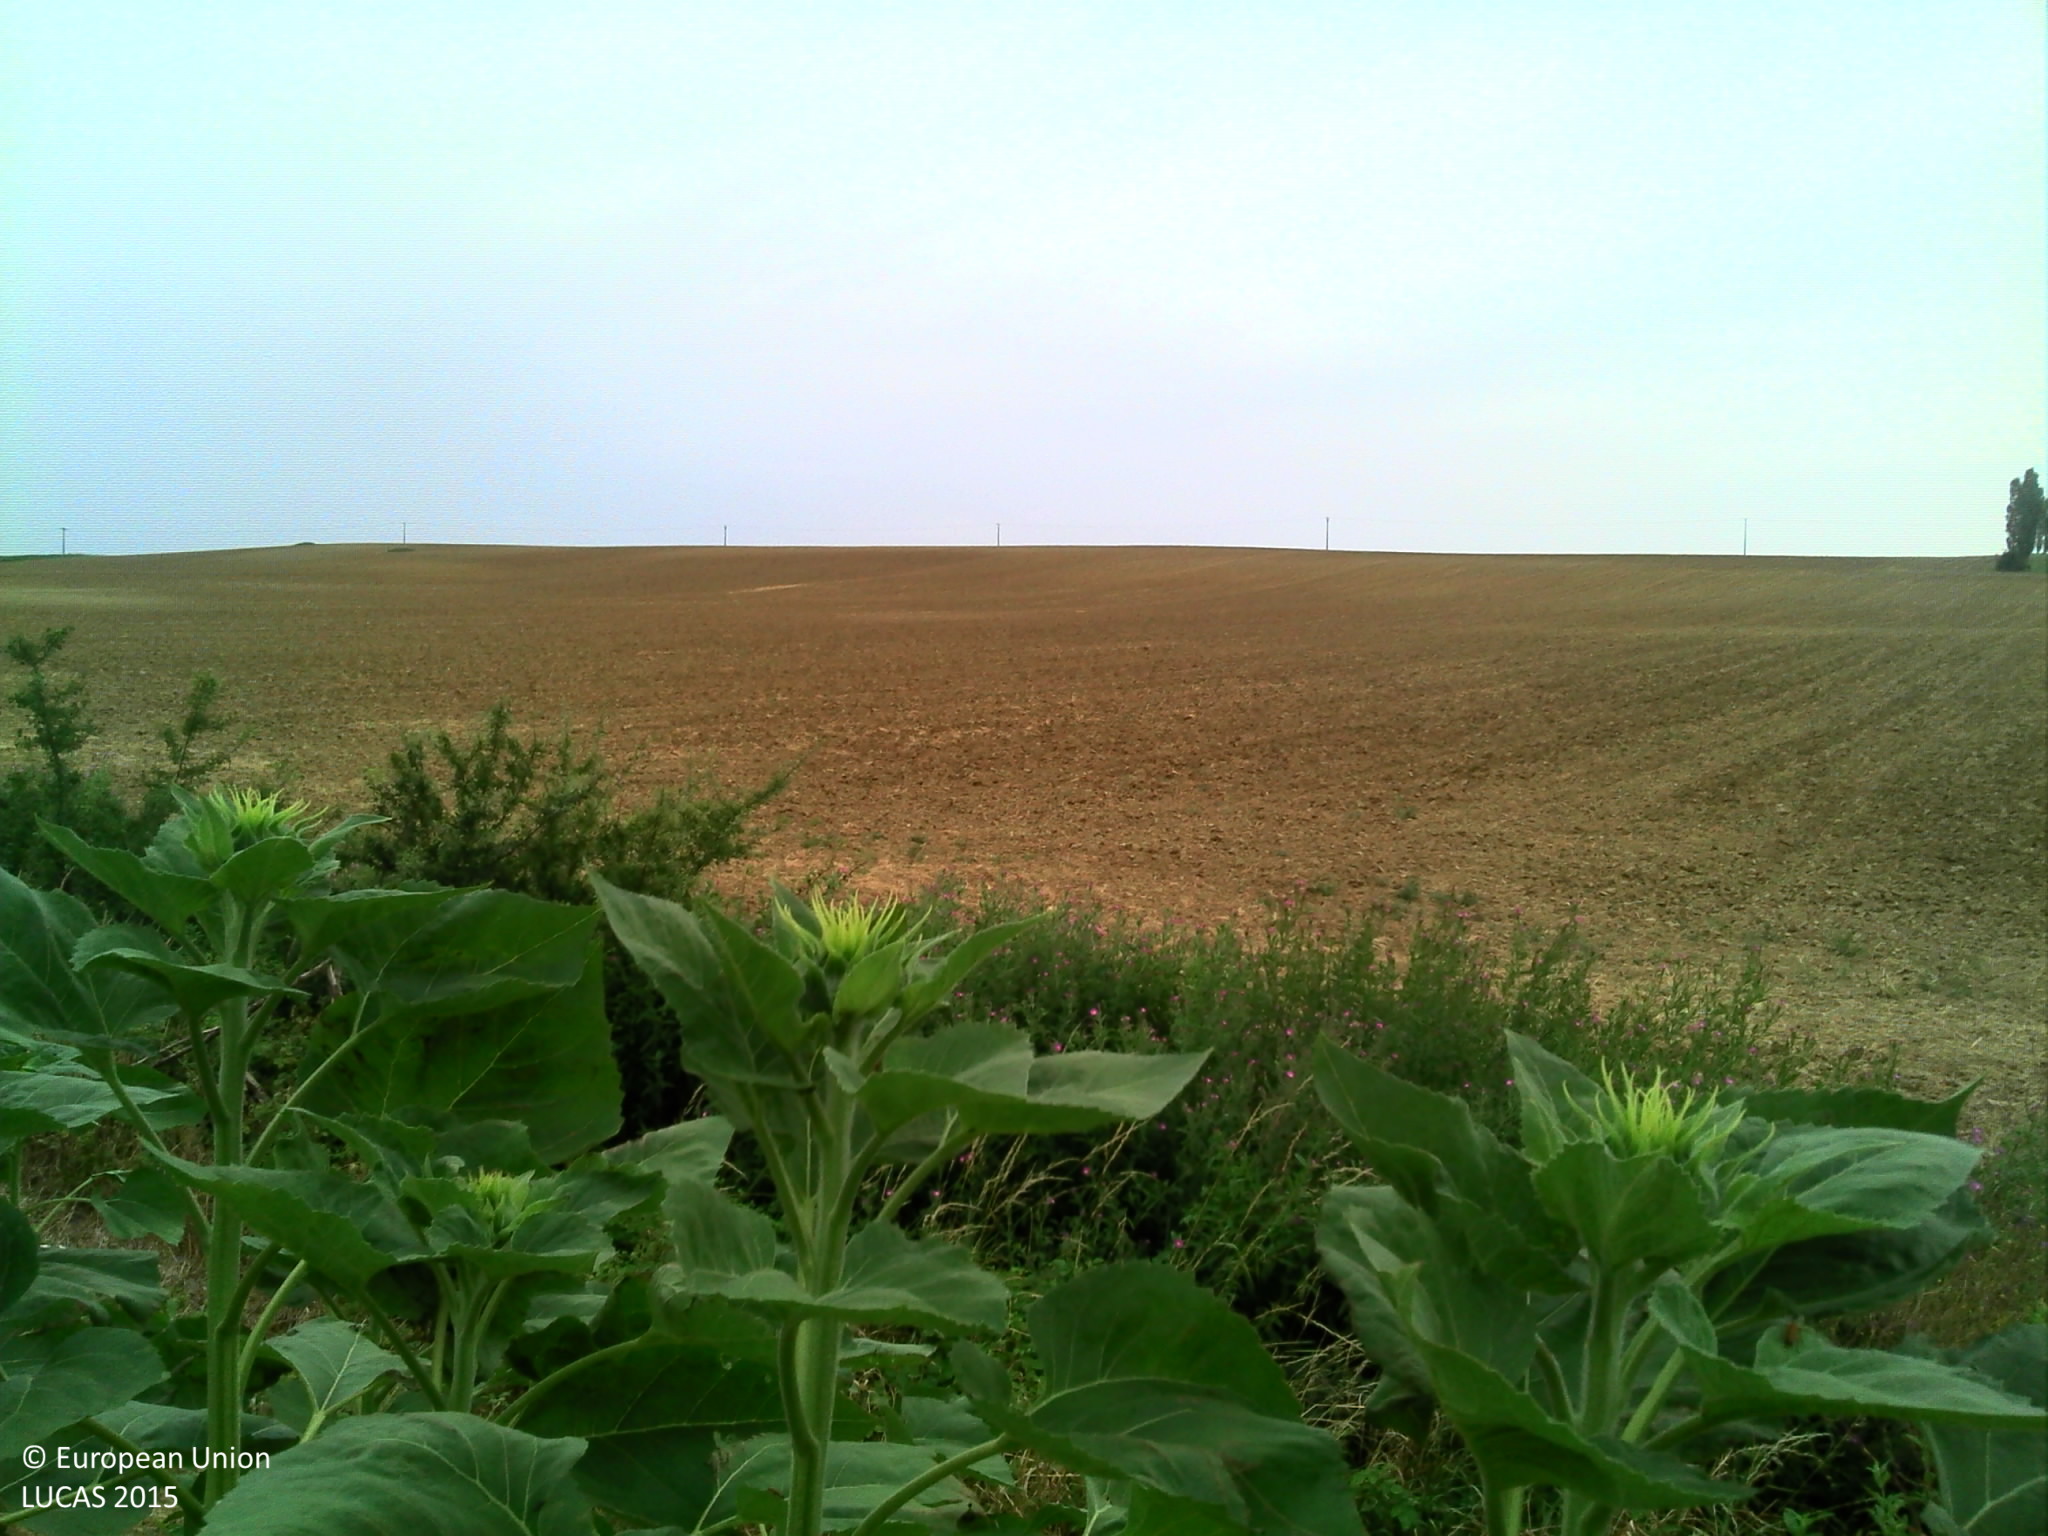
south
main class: Cropland
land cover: Sunflower
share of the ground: > 75 %
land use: Agriculture (excluding fallow land and kitchen gardens)
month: July
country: FR
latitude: 43.4785
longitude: 1.7584
